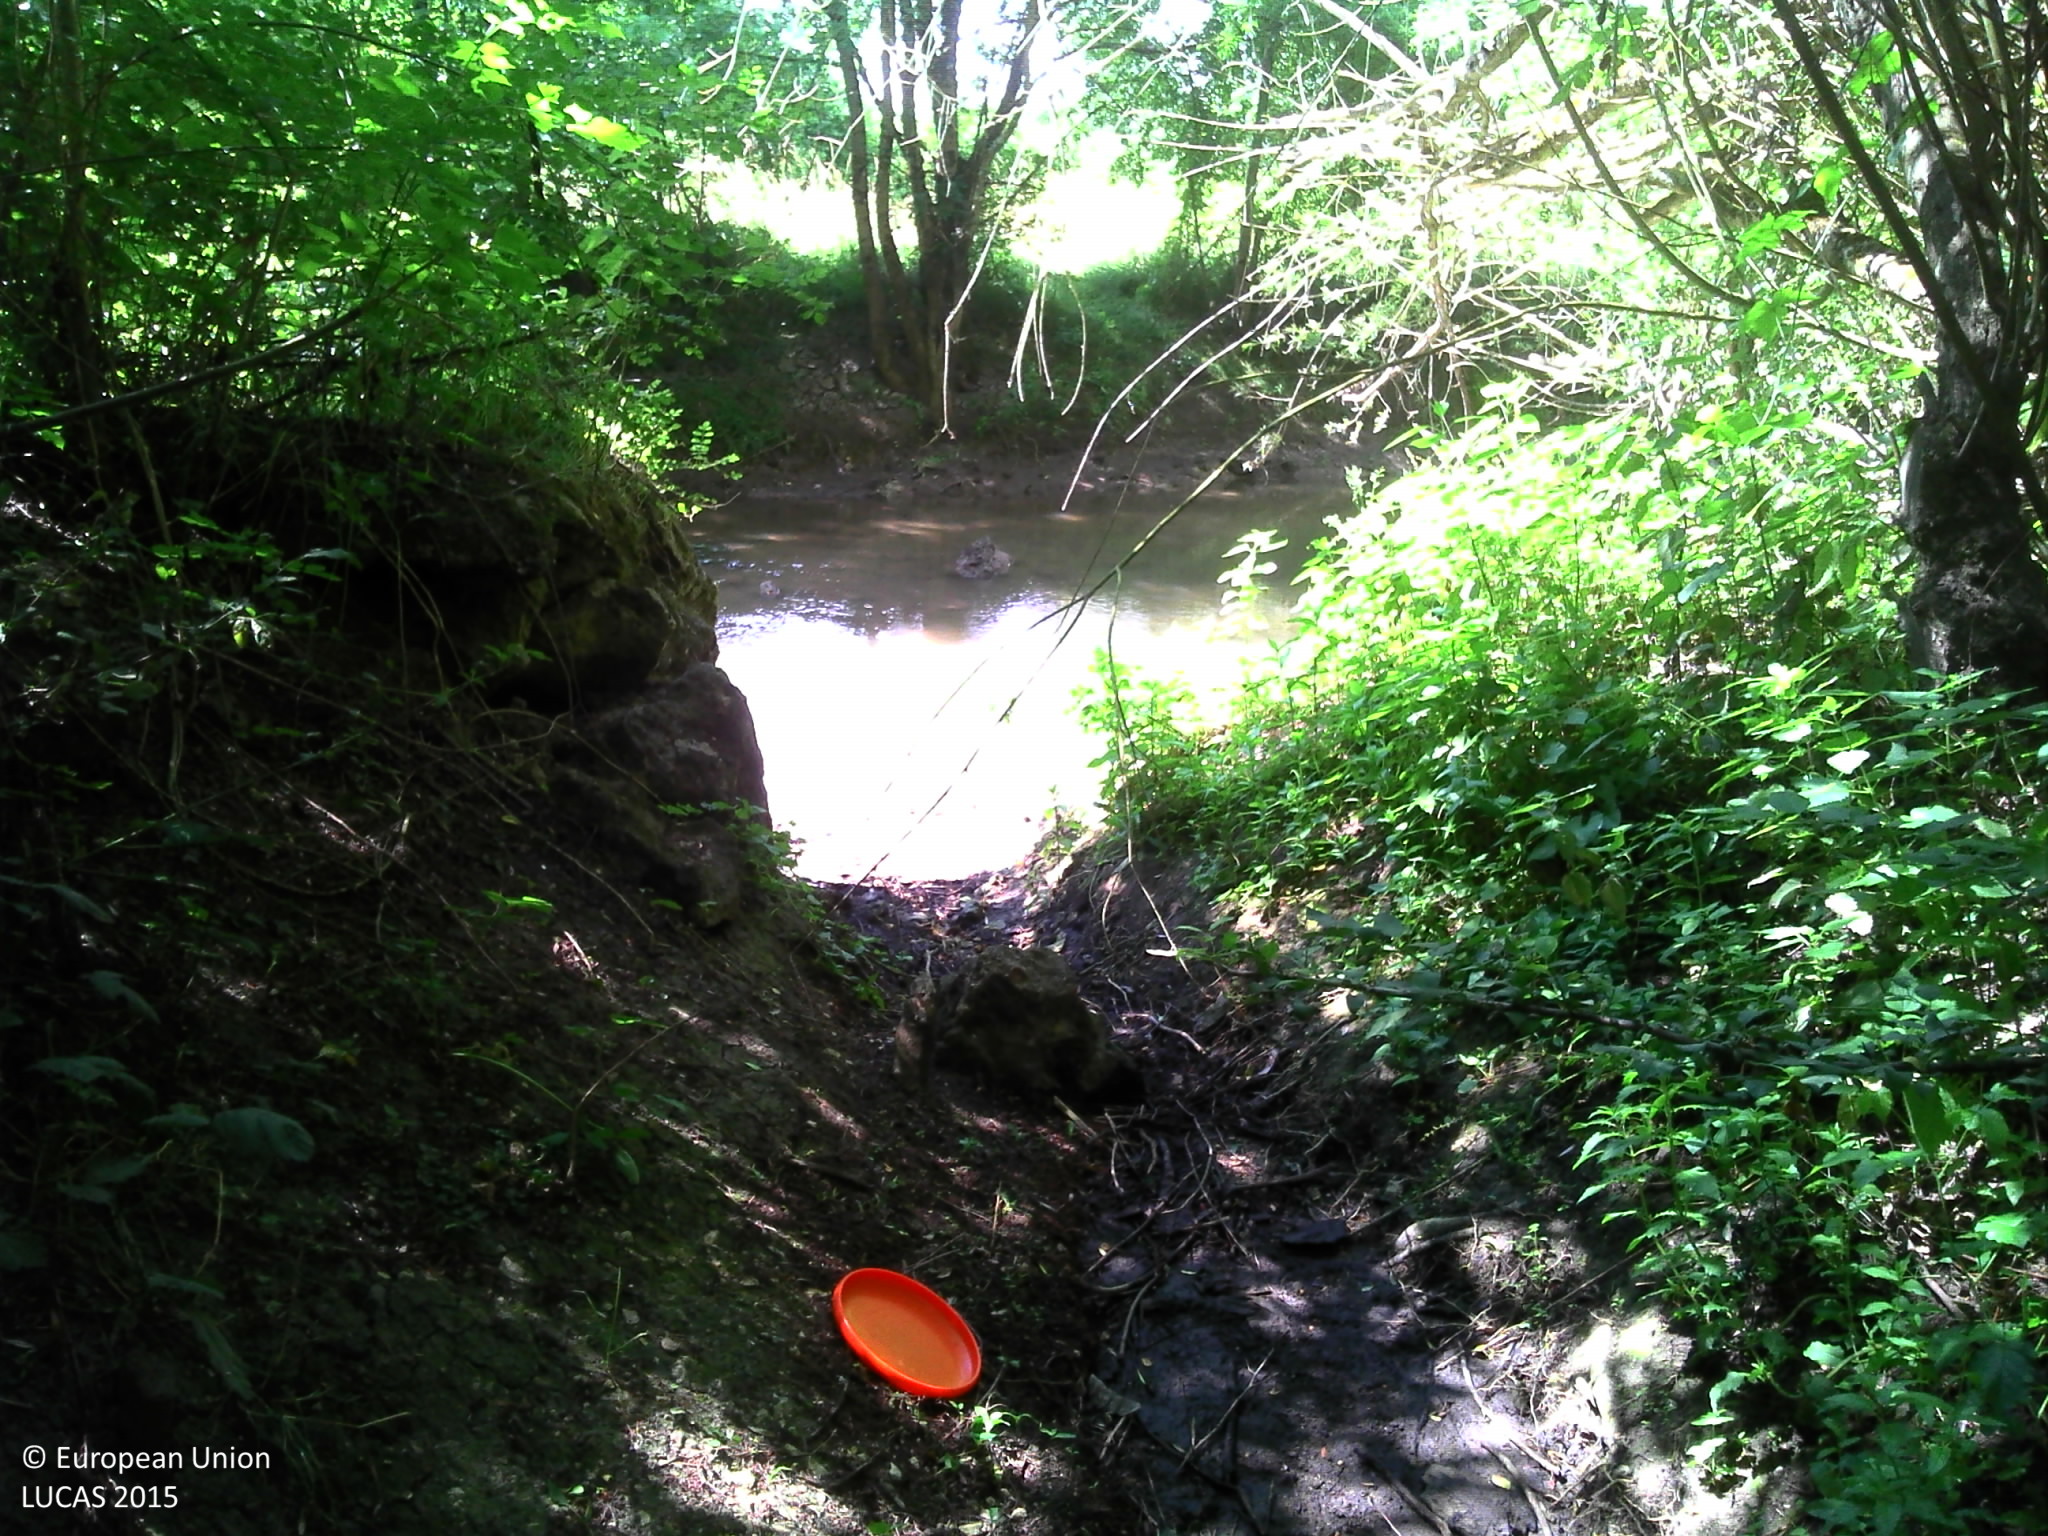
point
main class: Woodland
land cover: Broadleaved woodland
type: floodplain forest
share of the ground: > 75 %
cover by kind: broadleaved forest trees 75 %, herbaceous plants 15 %, shrubs 5 %, lichens and mosses 5 %
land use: Forestry
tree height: > 5 m
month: June
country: FR
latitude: 47.2762
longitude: 0.7944
